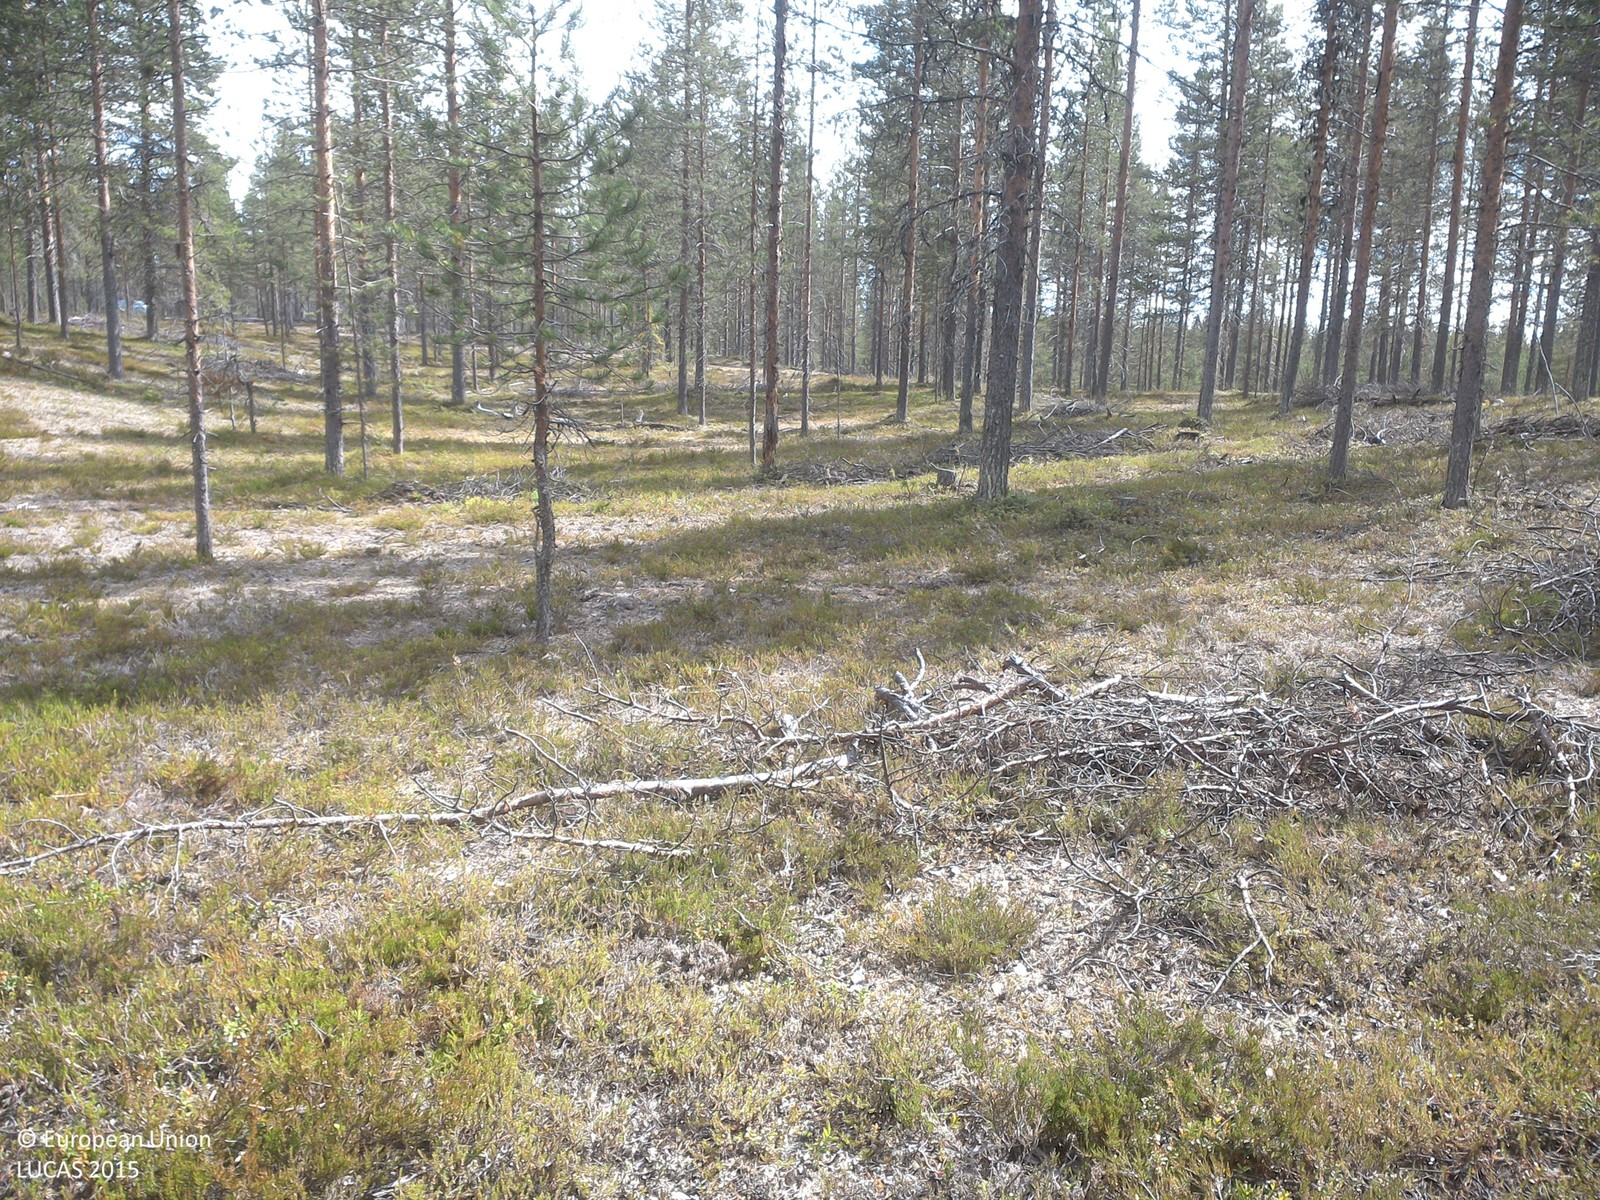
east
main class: Woodland
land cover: Pine dominated coniferous woodland
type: boreal forest
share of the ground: 10 - 25 %
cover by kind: shrubs 40 %, lichens and mosses 40 %, coniferous forest trees 20 %
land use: Forestry
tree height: > 5 m
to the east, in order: Pine dominated coniferous woodland; Tracks; Pine dominated coniferous woodland; Paved roads, cycling and walking lanes; Pine dominated coniferous woodland; Tracks; Pine dominated coniferous woodland
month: July
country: SE
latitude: 67.5129
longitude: 23.3450
